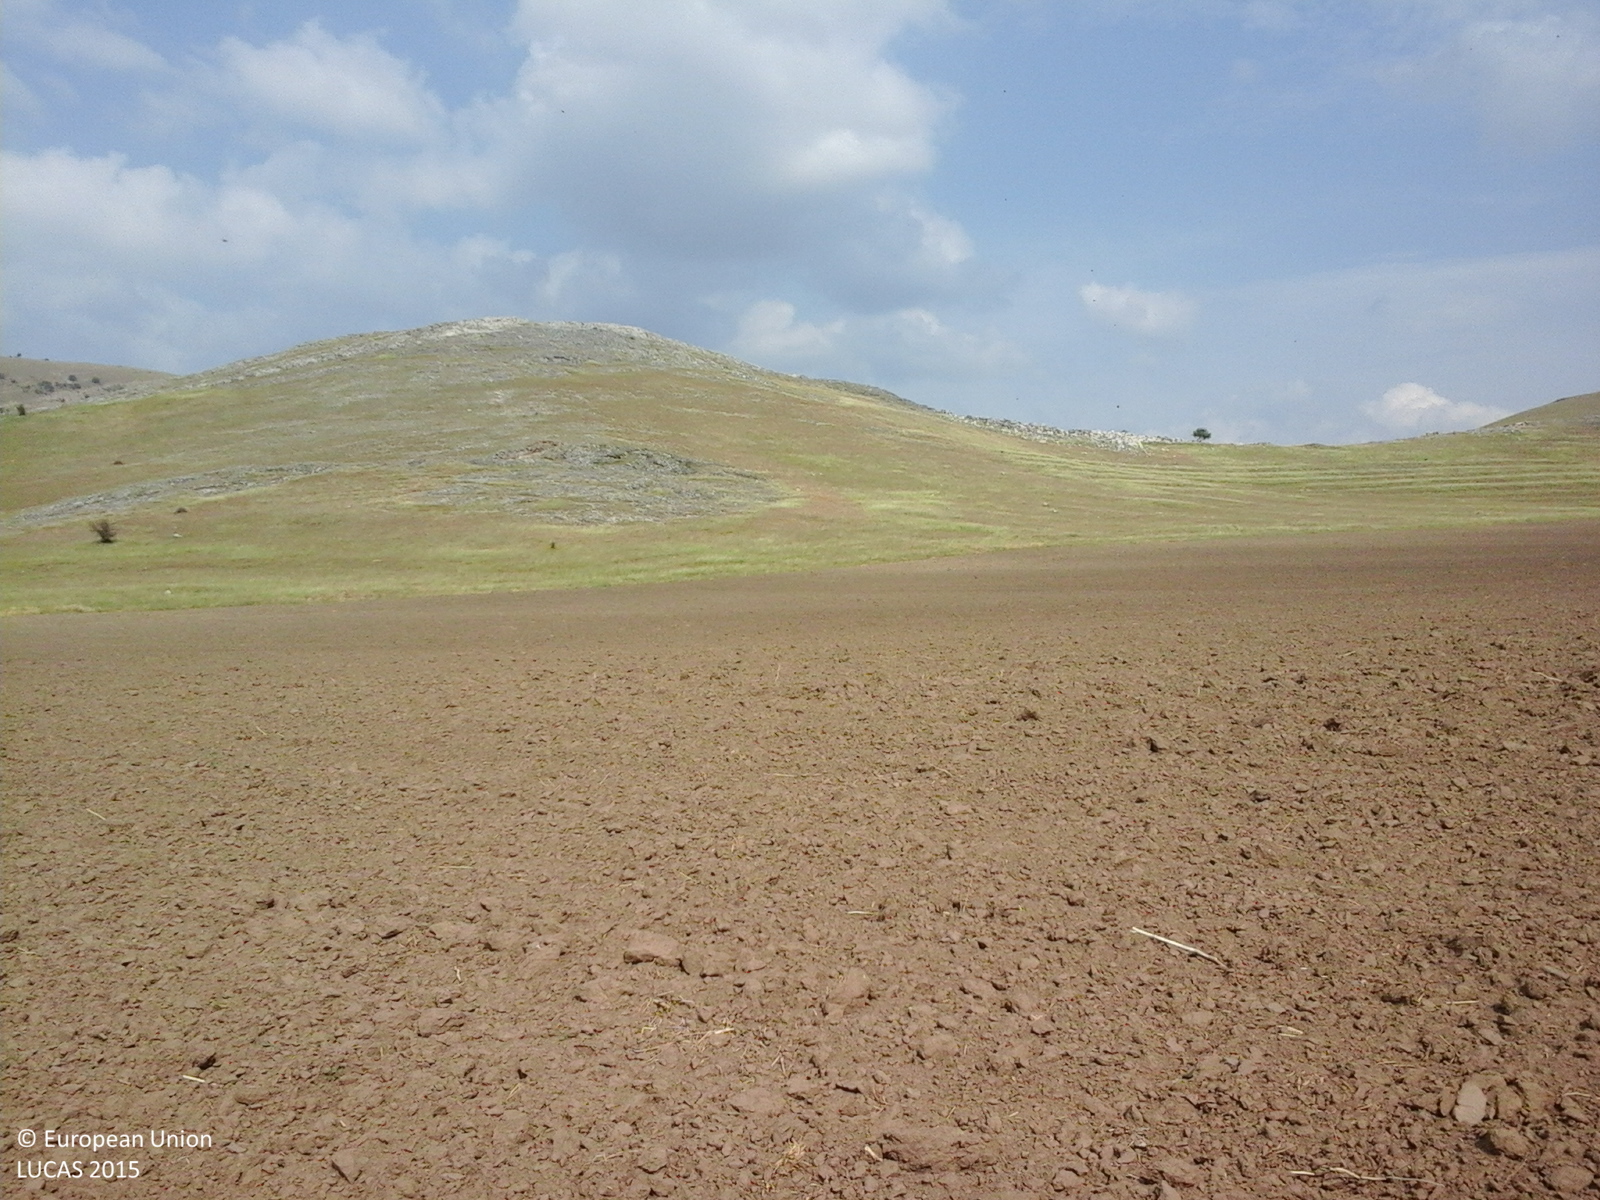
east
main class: Cropland
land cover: Rape and turnip rape
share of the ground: < 10 %
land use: Agriculture (excluding fallow land and kitchen gardens)
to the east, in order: Rape and turnip rape; Grassland without tree/shrub cover
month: July
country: RO
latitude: 45.1168
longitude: 28.2356
